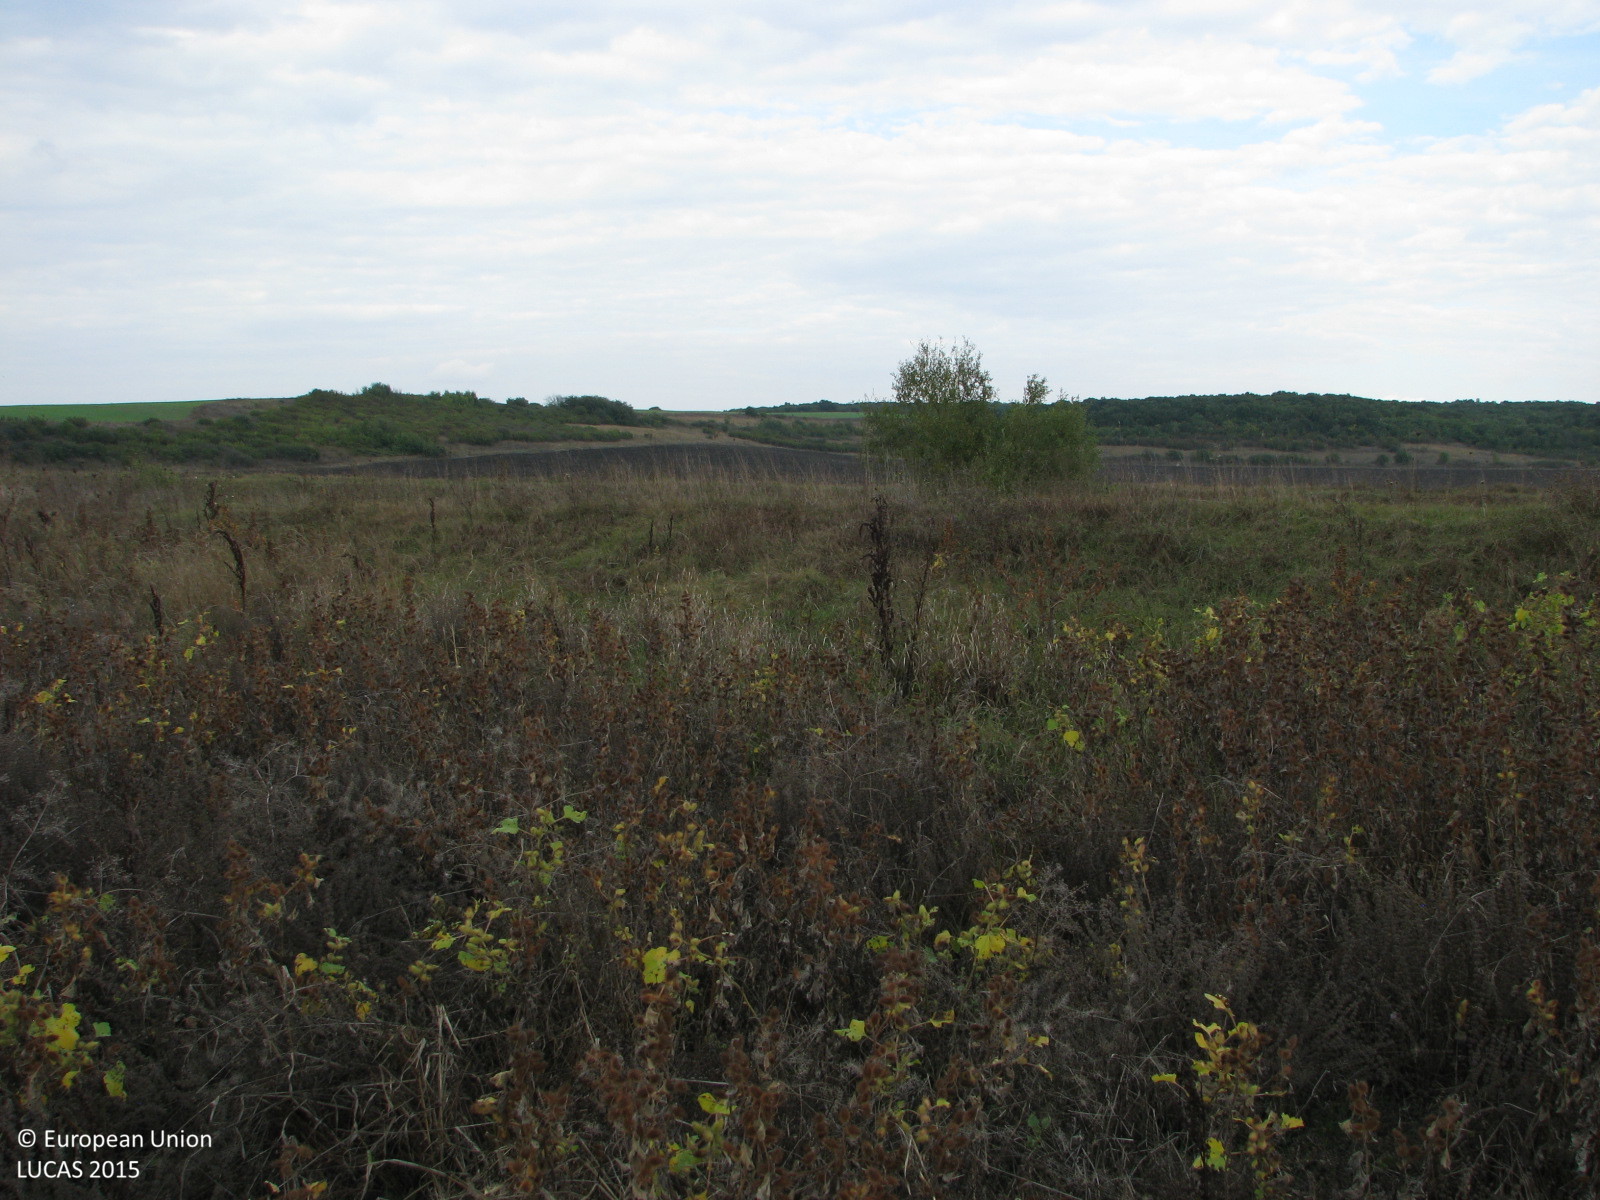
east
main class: Grassland
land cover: Spontaneously vegetated surfaces
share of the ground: > 75 %
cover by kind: herbaceous plants 100 %
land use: Fallow land
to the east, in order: Spontaneously vegetated surfaces; Tracks; Grassland without tree/shrub cover; Ditches and canals; Grassland without tree/shrub cover; Tracks; Grass margins; Other bare soil
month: October
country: BG
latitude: 42.2602
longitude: 26.4160
